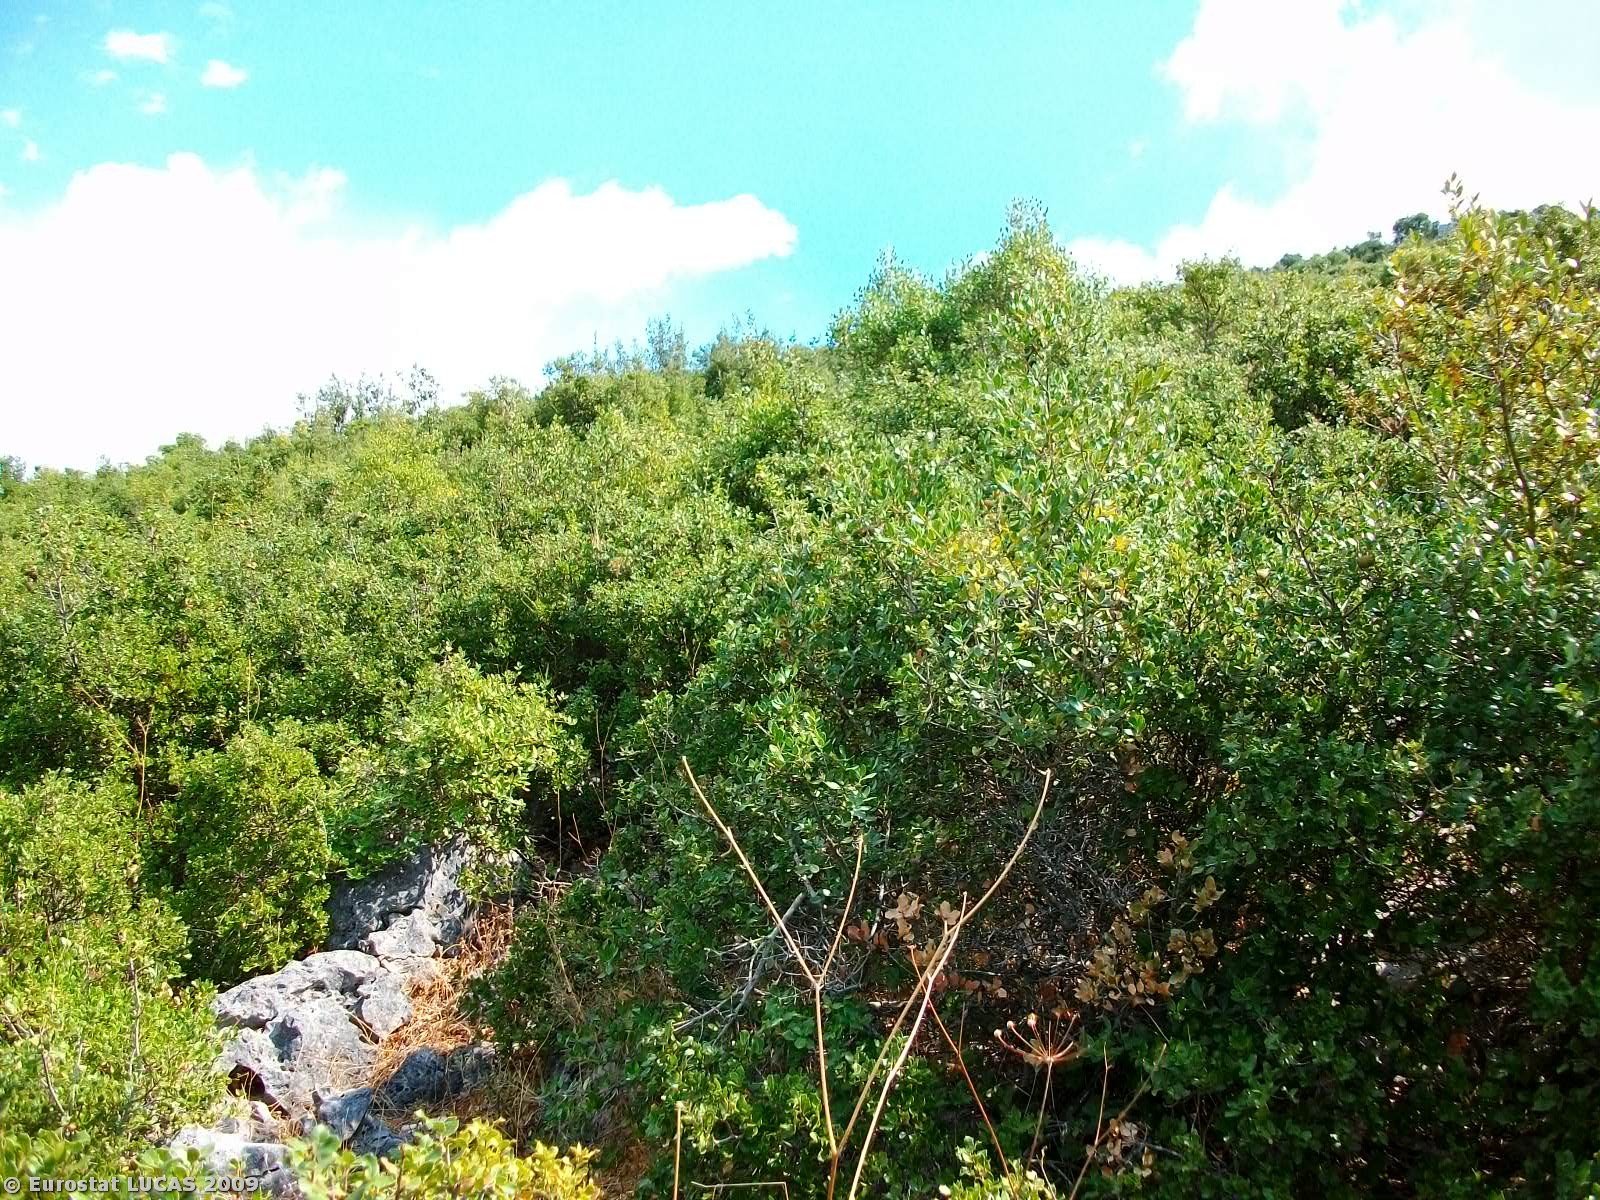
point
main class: Shrubland
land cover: Shrubland without tree cover
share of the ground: > 75 %
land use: Unused
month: September
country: GR
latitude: 39.3707
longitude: 20.3616
